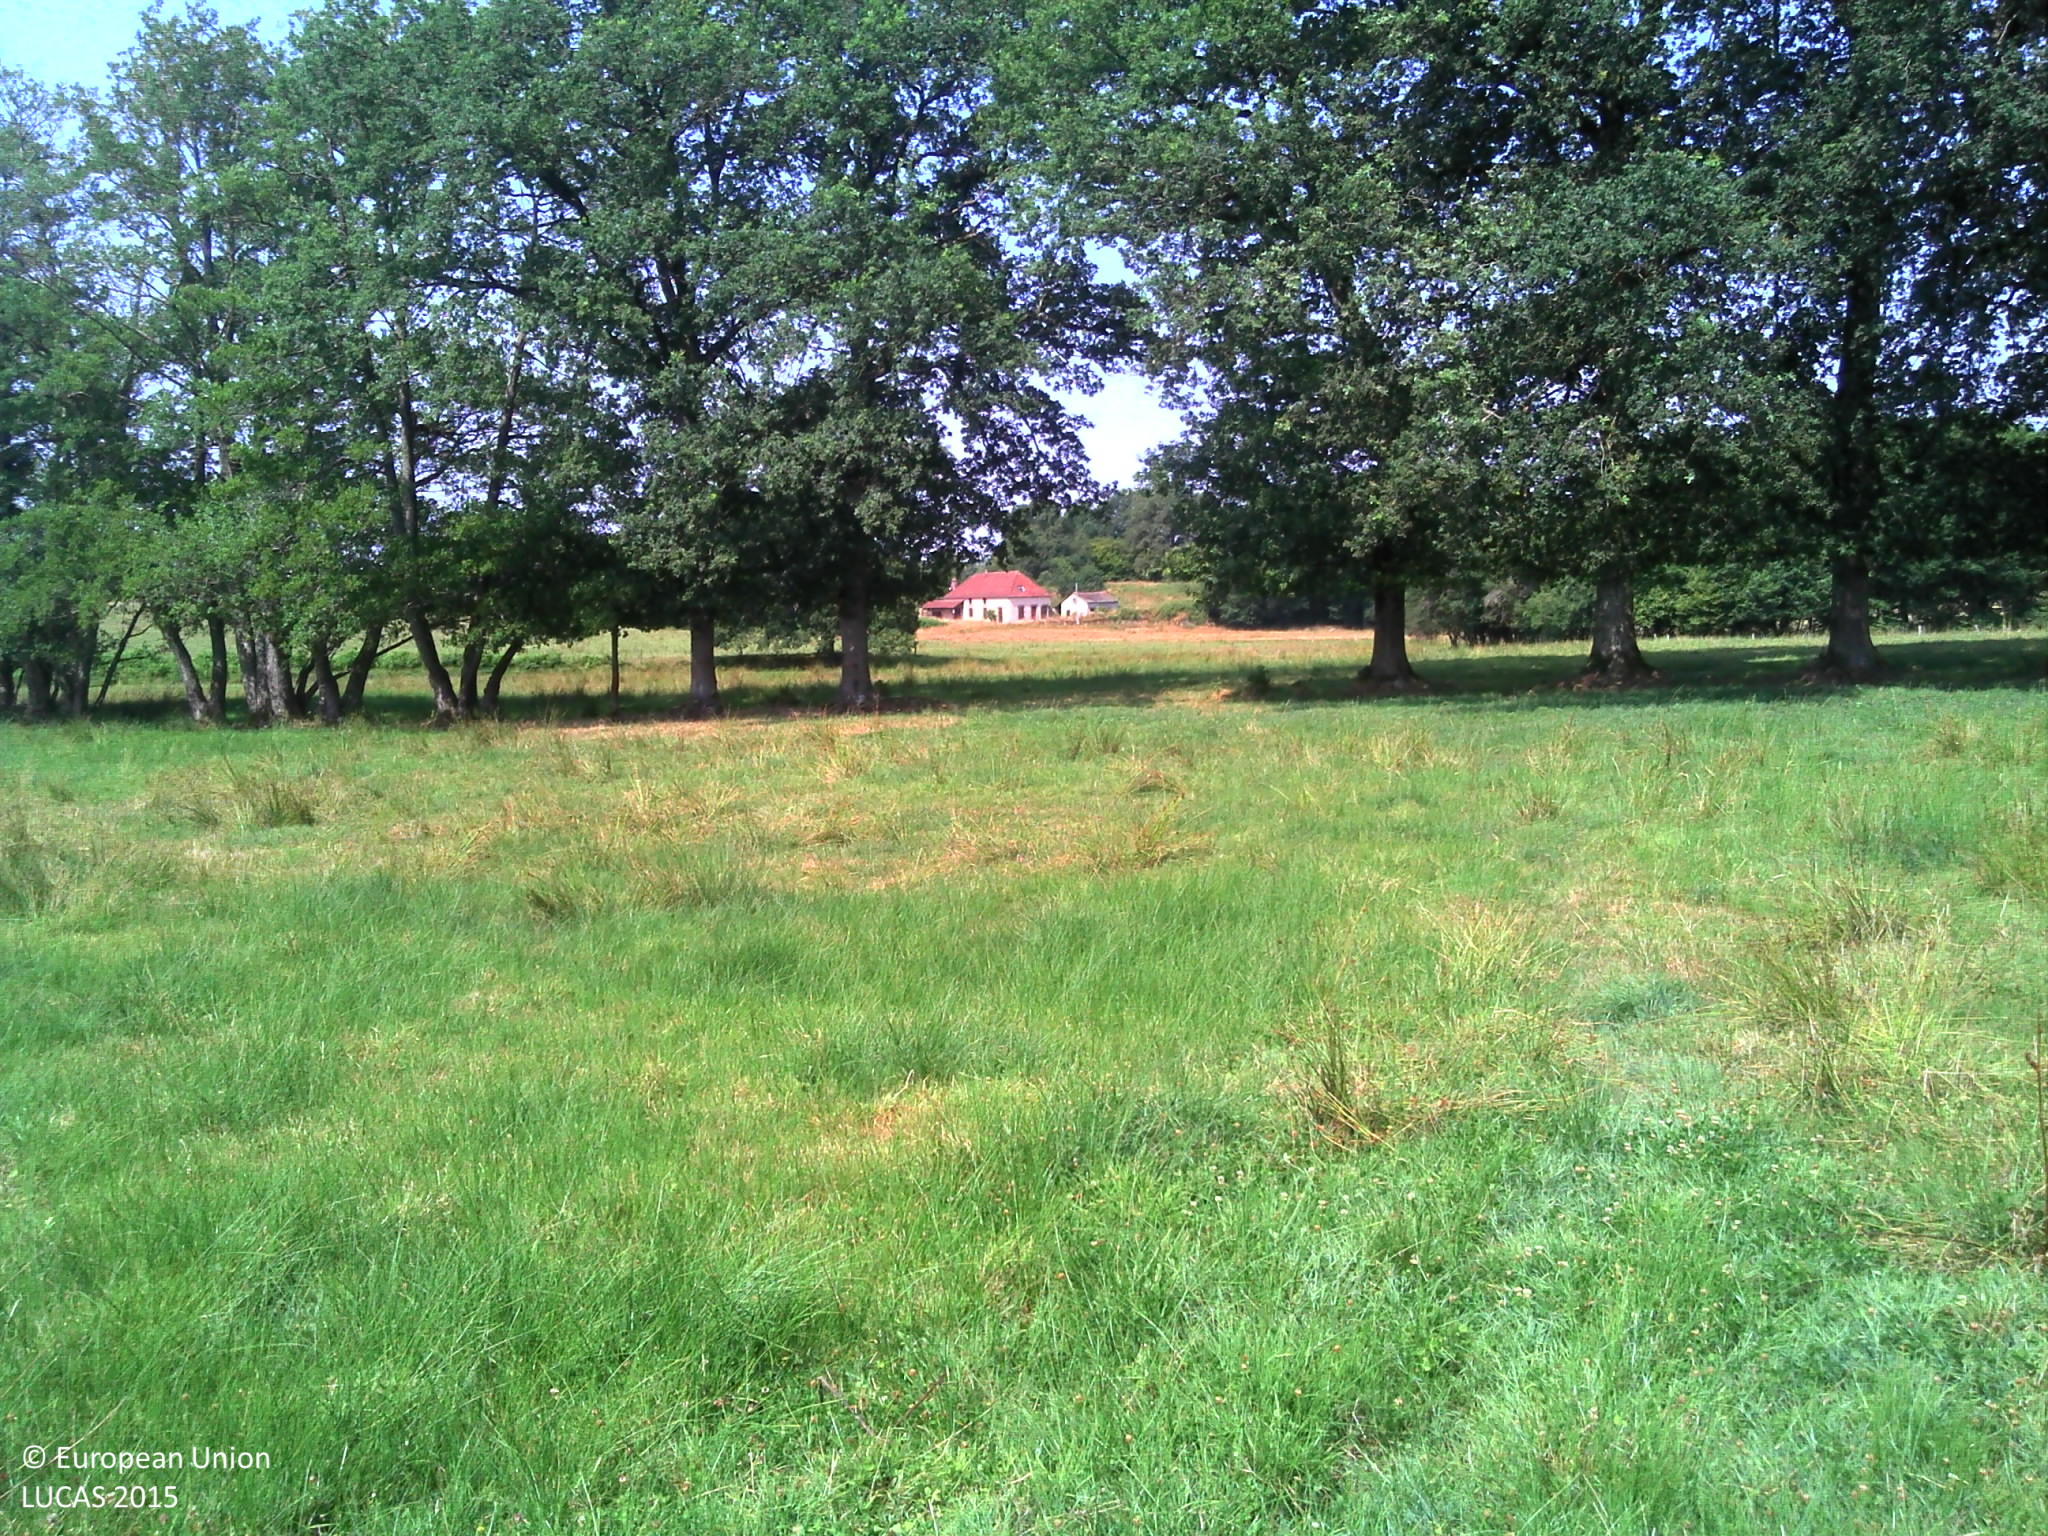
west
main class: Grassland
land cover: Grassland without tree/shrub cover
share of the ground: > 75 %
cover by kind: herbaceous plants 95 %, shrubs 5 %
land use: Agriculture (excluding fallow land and kitchen gardens)
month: July
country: FR
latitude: 46.0470
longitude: 1.7087
